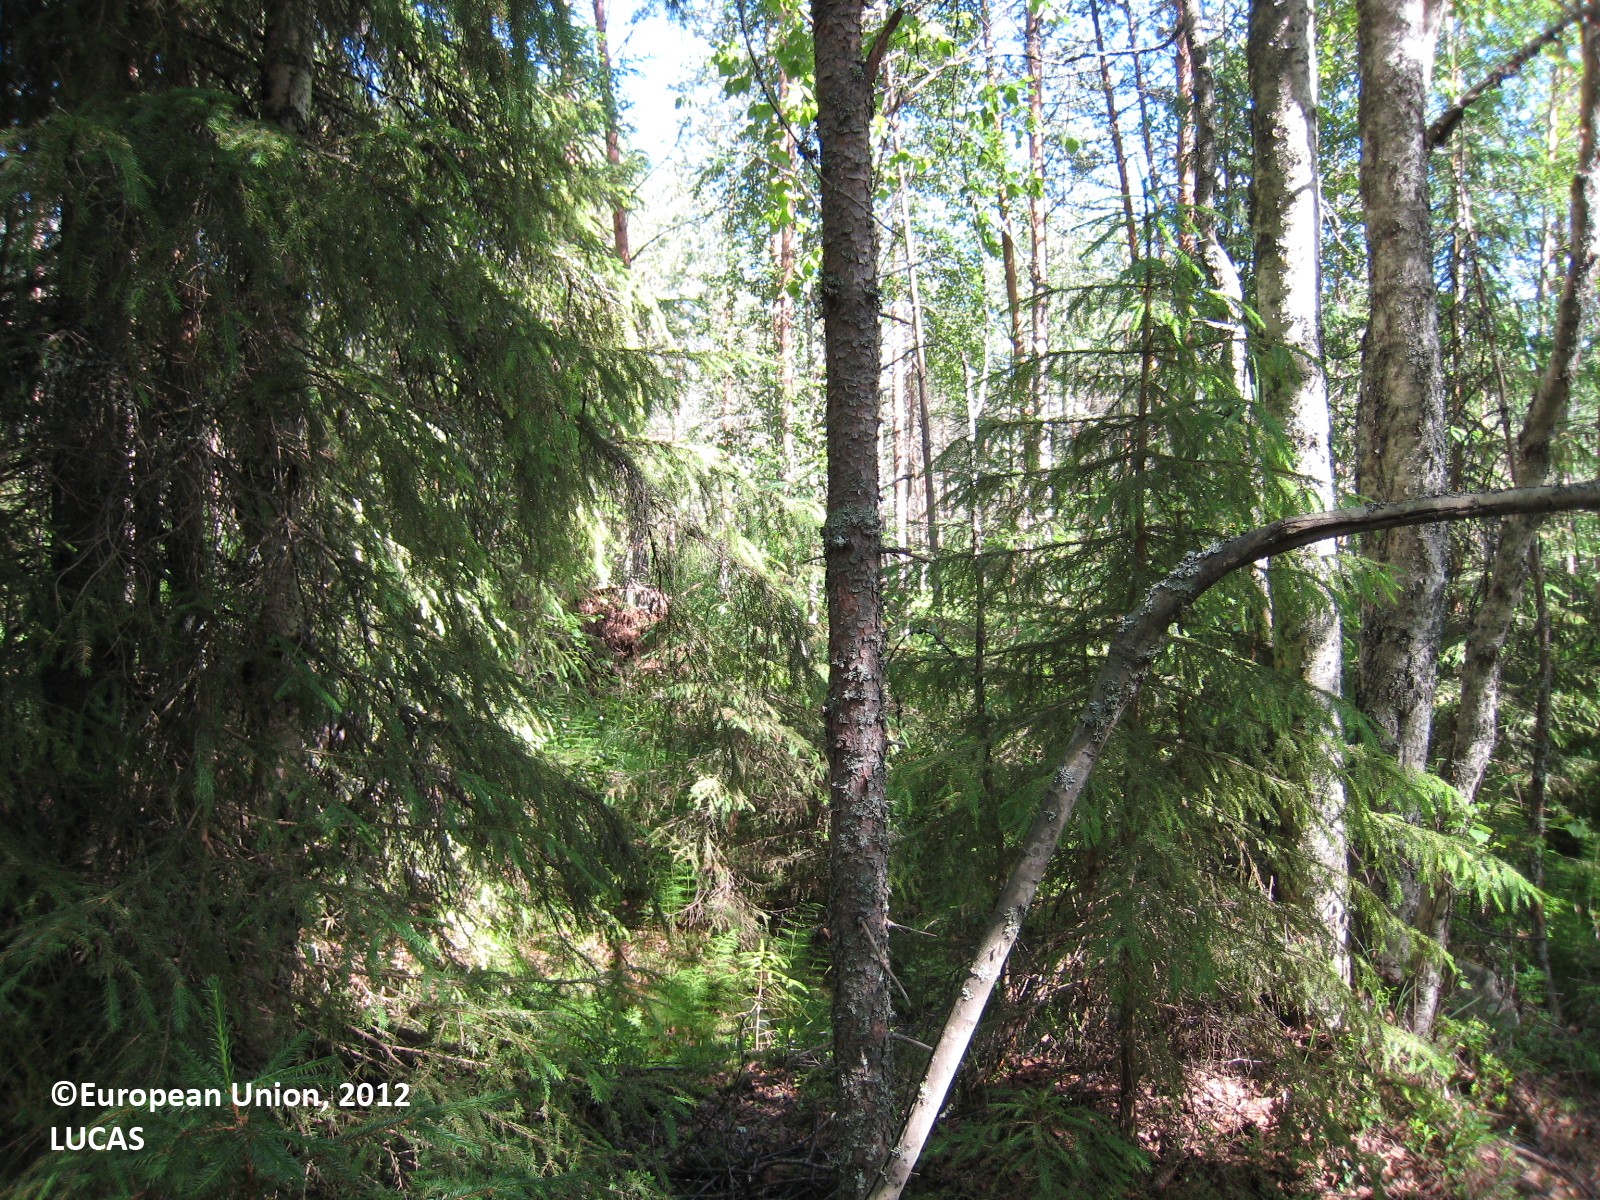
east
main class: Woodland
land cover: Other mixed woodland
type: boreal forest
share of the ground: > 75 %
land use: Forestry
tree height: > 5 m
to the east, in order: Other mixed woodland; Ditches and canals; Other mixed woodland; Pine dominated coniferous woodland; Ditches and canals; Pine dominated coniferous woodland; Ditches and canals; Pine dominated coniferous woodland; Ditches and canals; Pine dominated coniferous woodland; Ditches and canals; Pine dominated coniferous woodland; Ditches and canals; Pine dominated coniferous woodland; Ditches and canals; Pine dominated coniferous woodland; Broadleaved woodland; Ditches and canals; Electric lines; Grassland with sparse tree/shrub cover; Pine dominated mixed woodland; Other mixed woodland
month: July
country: FI
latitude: 63.0395
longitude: 25.6697
